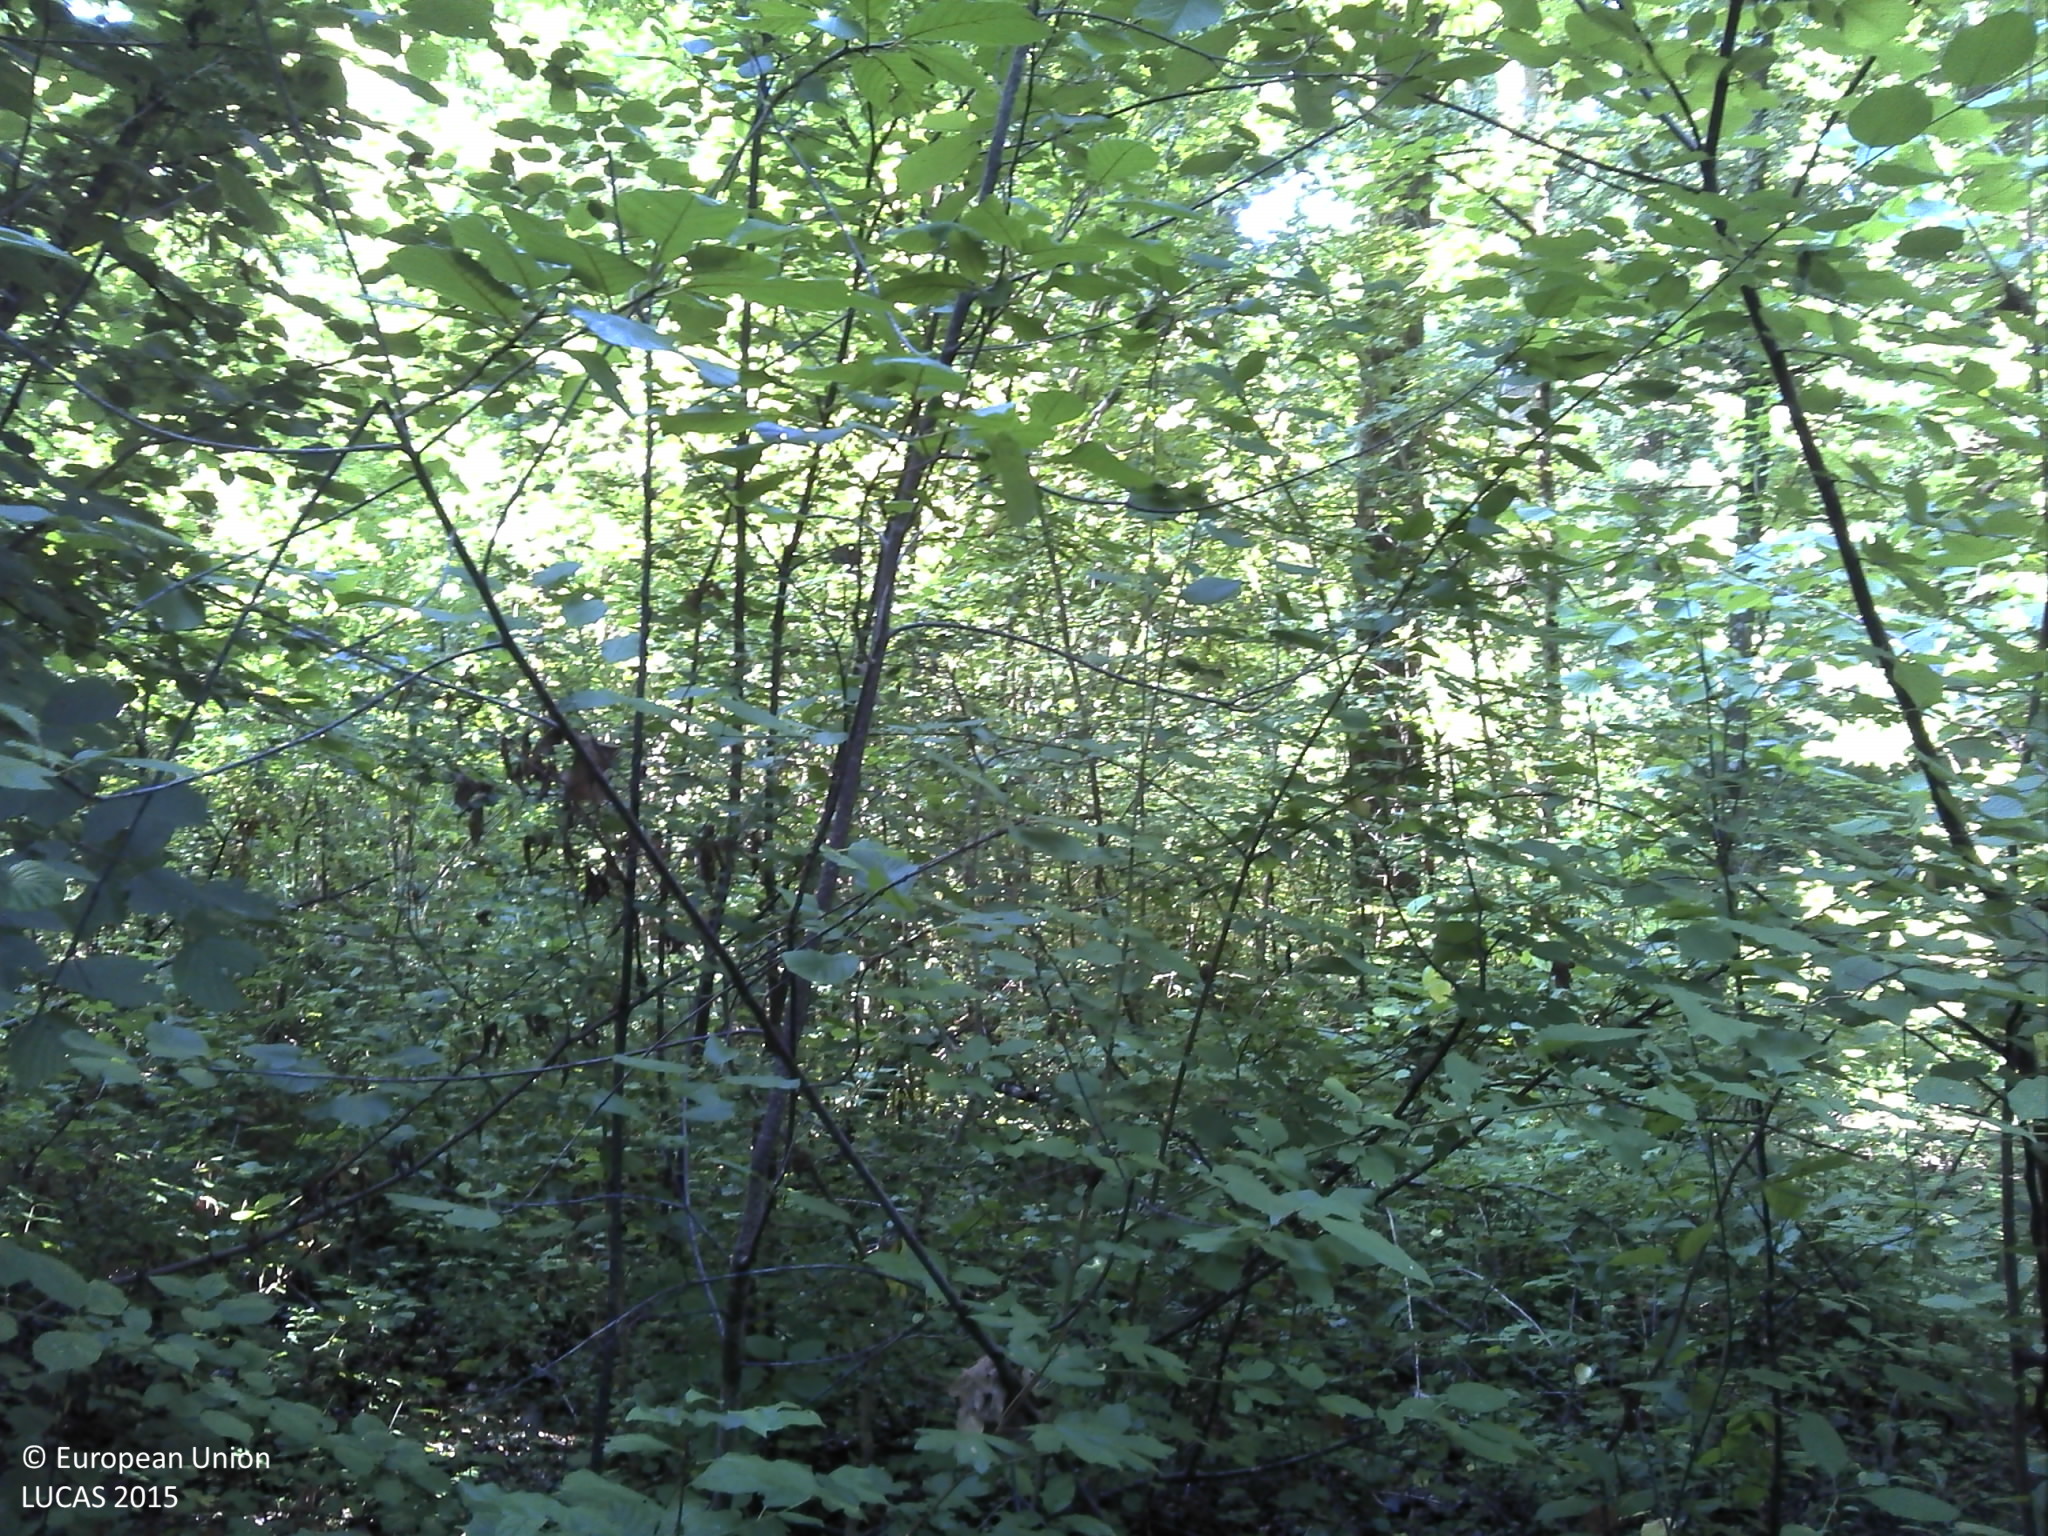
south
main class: Woodland
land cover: Broadleaved woodland
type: acidophilous oak and oak-birch forest
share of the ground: > 75 %
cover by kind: broadleaved forest trees 80 %, lichens and mosses 20 %
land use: Forestry
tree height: > 5 m
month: August
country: HR
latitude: 45.5739
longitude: 16.5210
